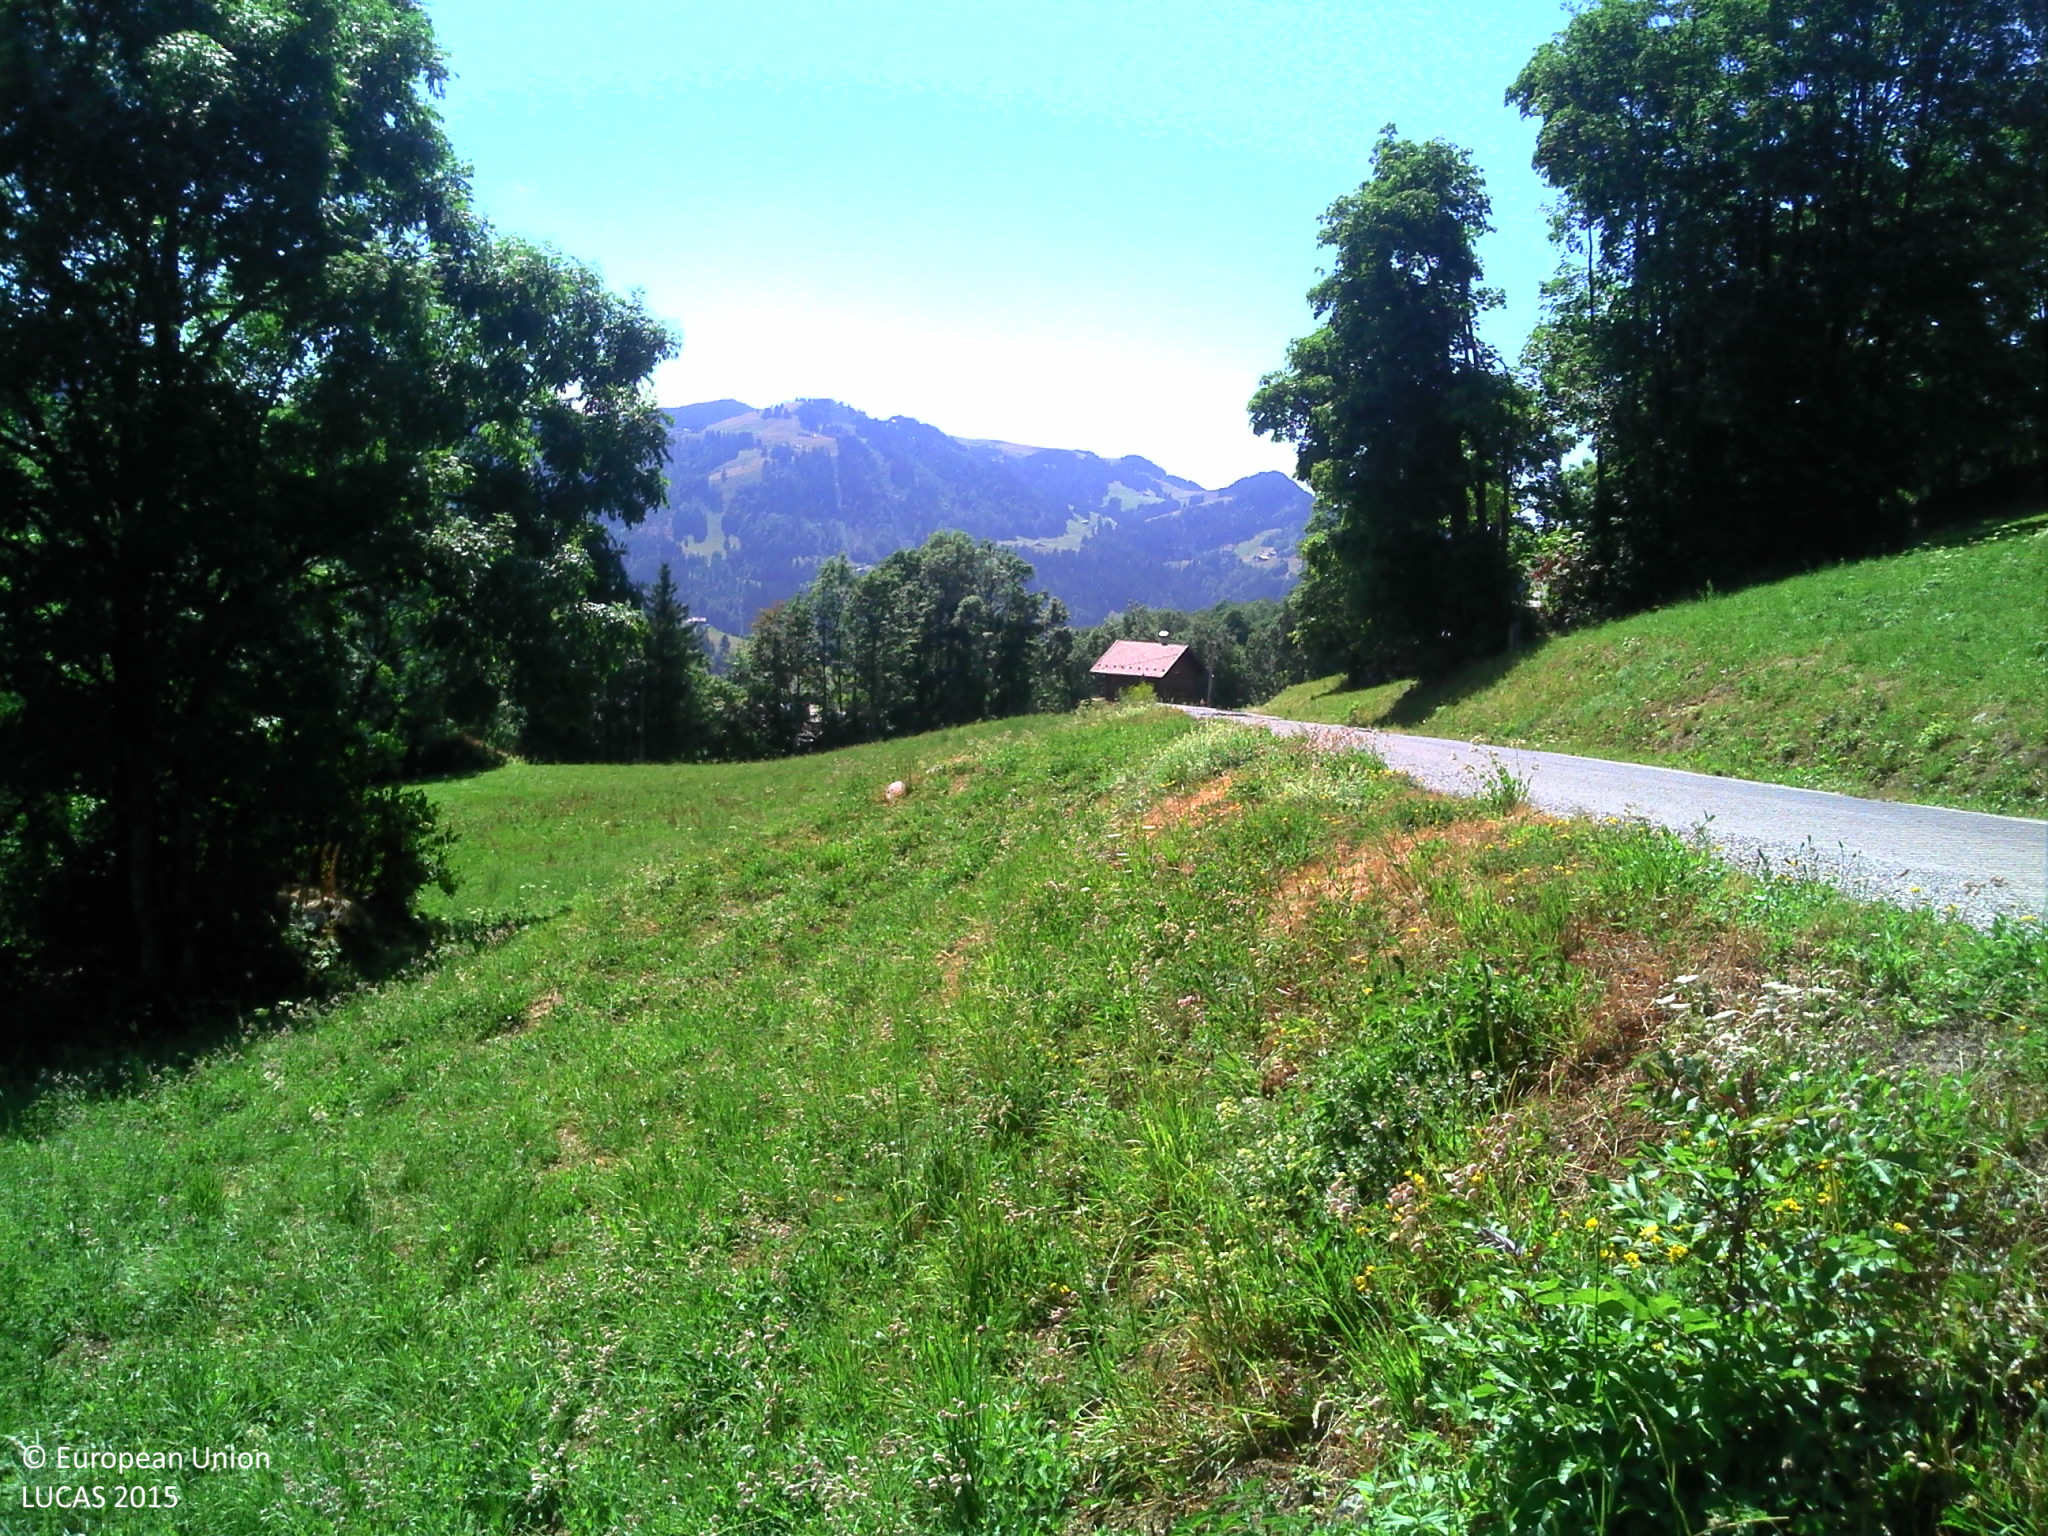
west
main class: Grassland
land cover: Grassland with sparse tree/shrub cover
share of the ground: > 75 %
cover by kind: herbaceous plants 95 %, broadleaved forest trees 5 %
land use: Agriculture (excluding fallow land and kitchen gardens)
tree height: > 5 m
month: July
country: FR
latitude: 45.9139
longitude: 6.4585
